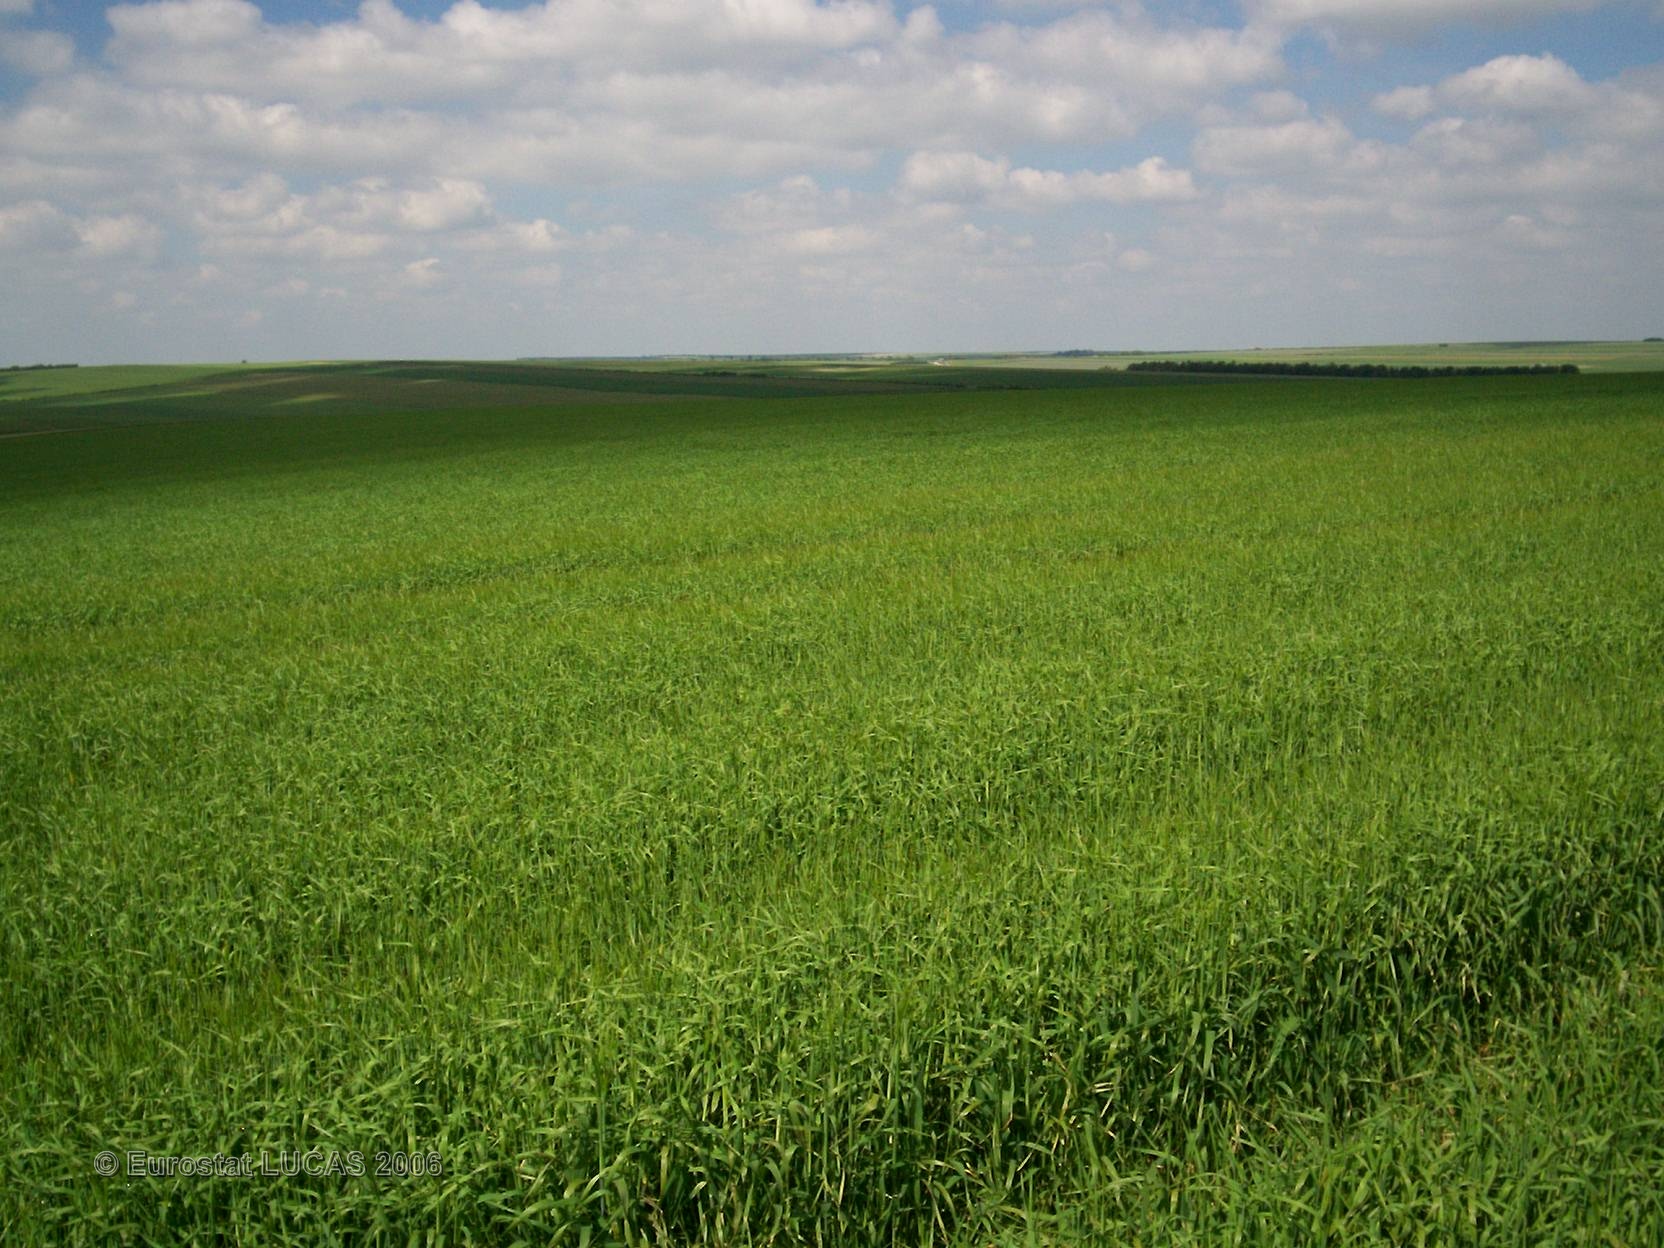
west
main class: Cropland
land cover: Barley
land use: Agriculture (excluding fallow land and kitchen gardens)
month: June
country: FR
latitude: 48.7695
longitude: 4.4591
